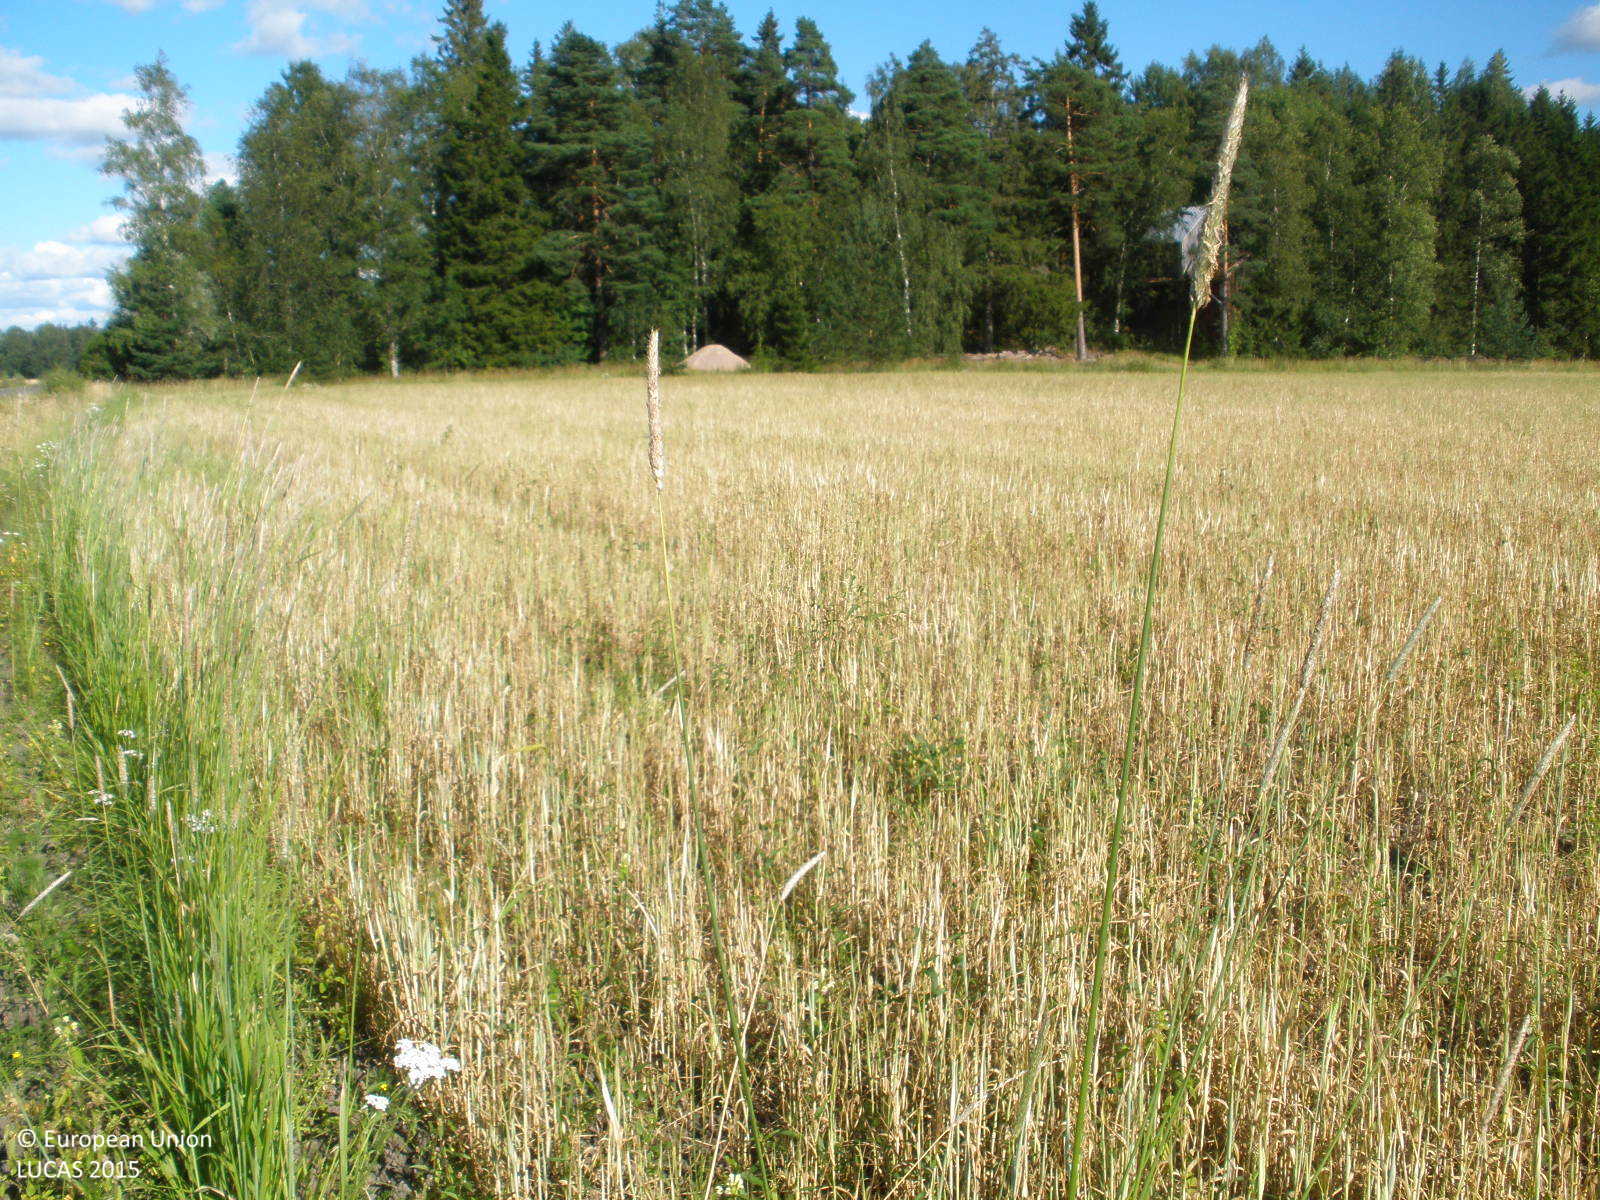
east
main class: Cropland
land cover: Barley
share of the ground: 50 - 75 %
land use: Agriculture (excluding fallow land and kitchen gardens)
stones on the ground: < 10 %
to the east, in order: Barley; Grass margins; Ditches and canals; Grass margins; Tracks; Spruce dominated mixed woodland; Artificial constructions in urban areas; Spruce dominated mixed woodland; Other leguminous and mixtures for fodder
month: August
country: FI
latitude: 60.5498
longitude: 23.3392
